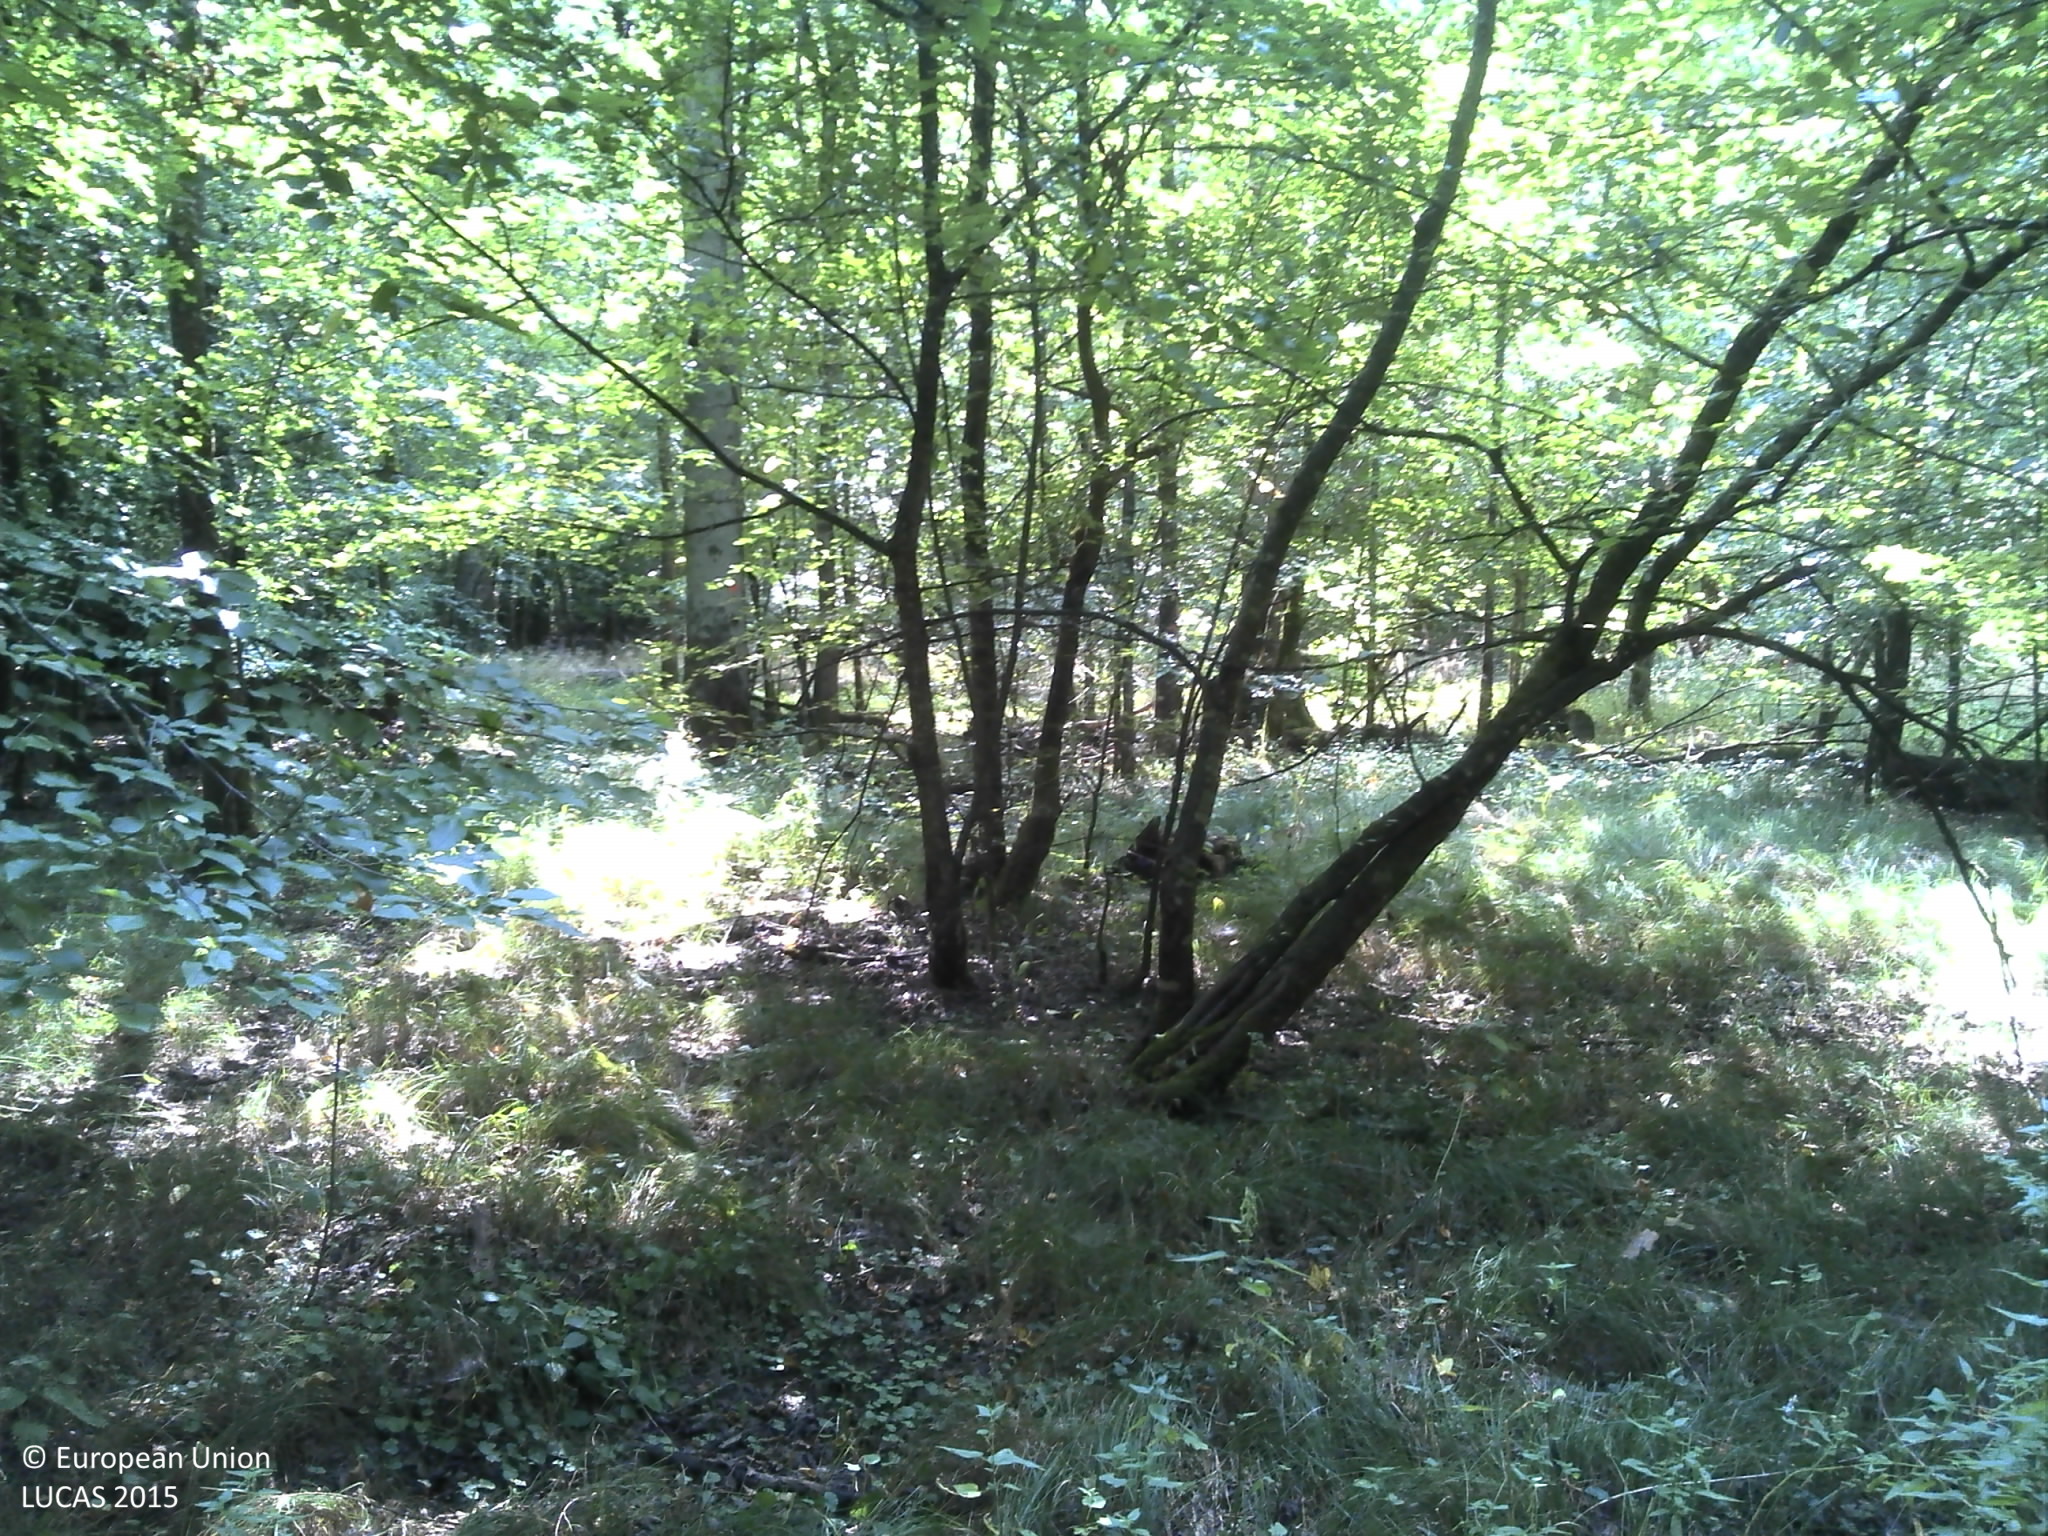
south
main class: Woodland
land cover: Broadleaved woodland
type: mesophytic deciduous forest
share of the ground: > 75 %
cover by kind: broadleaved forest trees 100 %
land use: Forestry
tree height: > 5 m
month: September
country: HR
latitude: 45.6784
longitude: 16.5850
